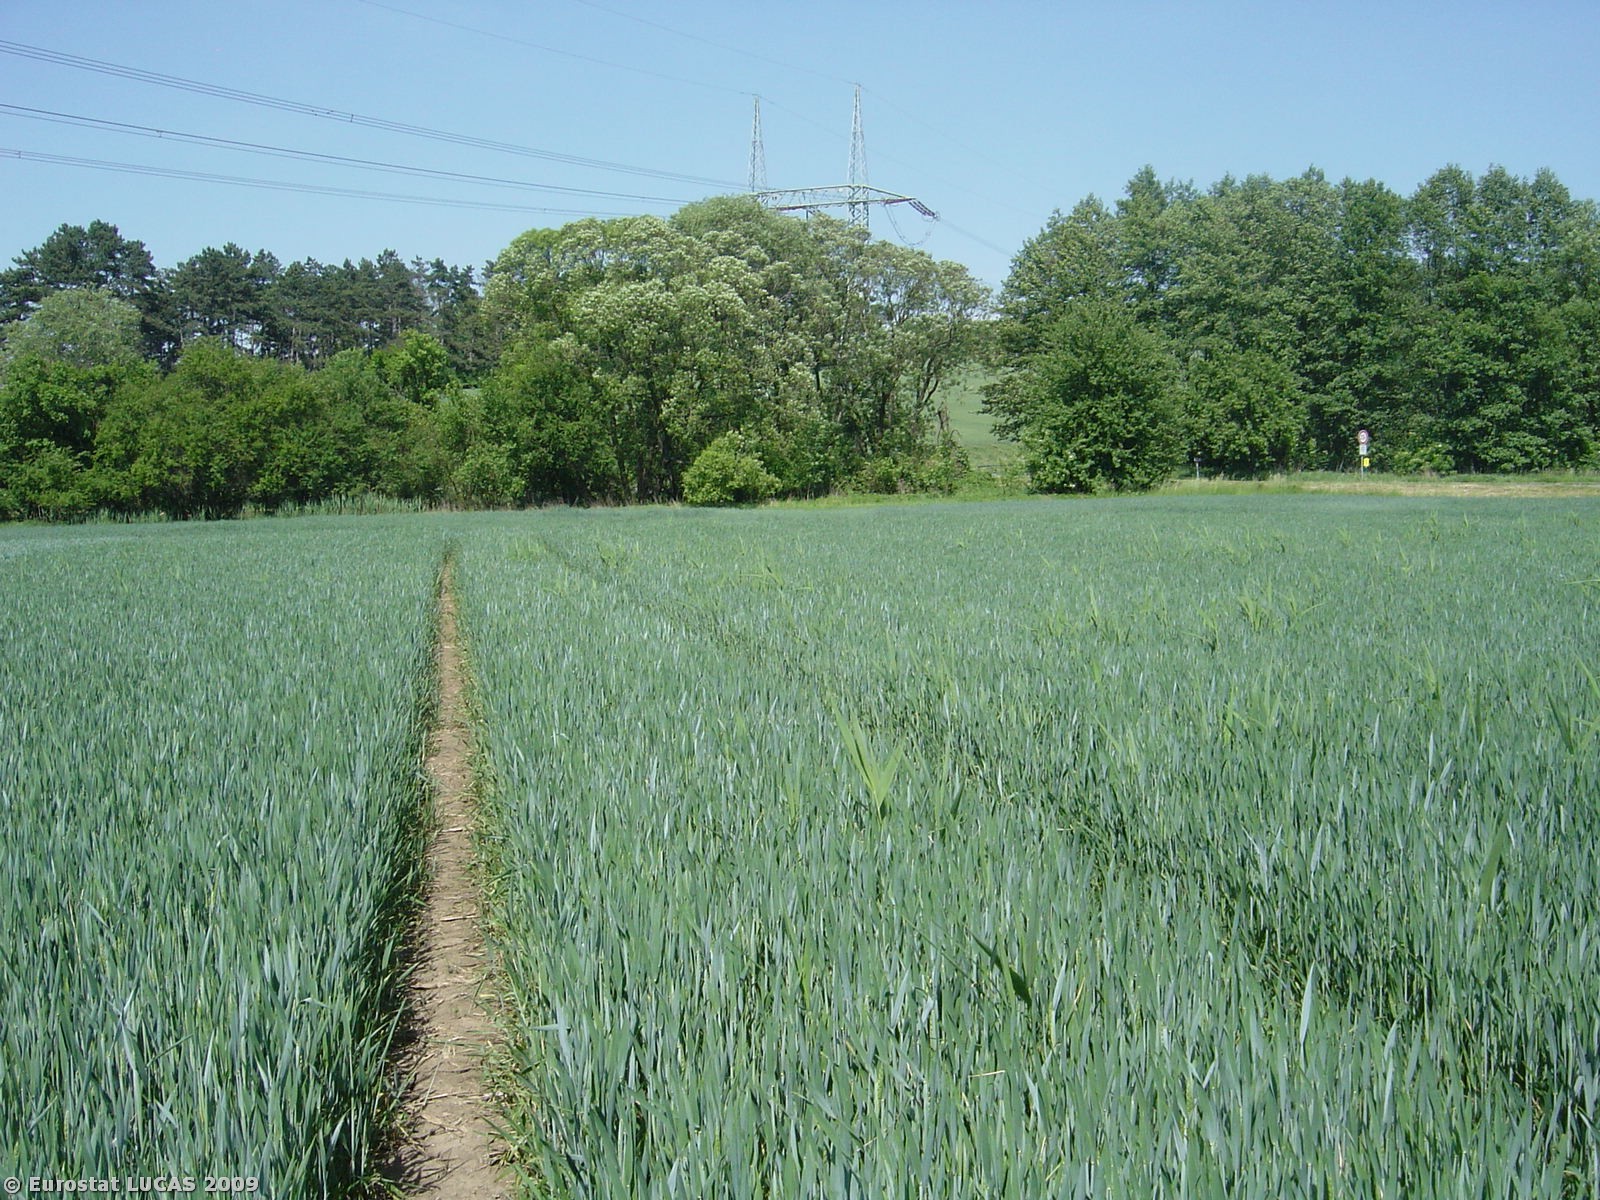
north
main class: Cropland
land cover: Common wheat
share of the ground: > 75 %
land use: Agriculture (excluding fallow land and kitchen gardens)
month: May
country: CZ
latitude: 49.1614
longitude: 17.2096
